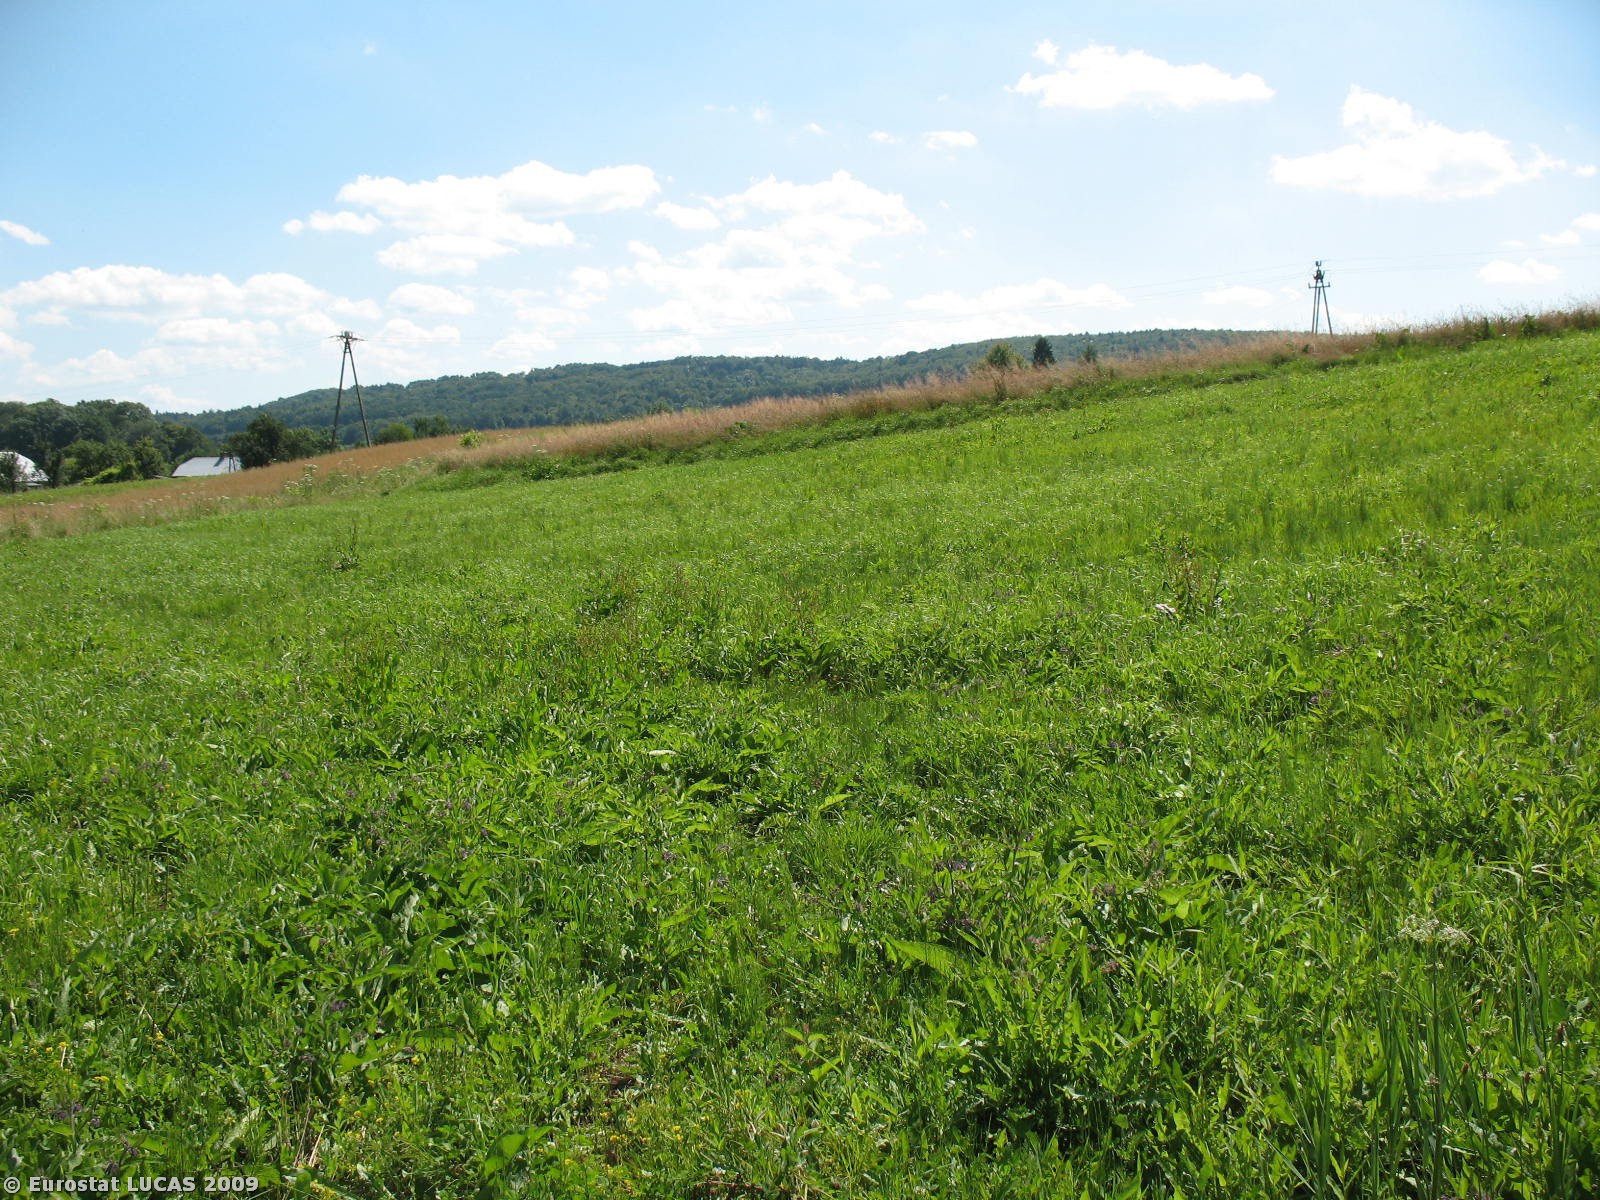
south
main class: Grassland
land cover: Grassland without tree/shrub cover
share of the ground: > 75 %
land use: Agriculture (excluding fallow land and kitchen gardens)
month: July
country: PL
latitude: 49.6792
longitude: 21.9610
